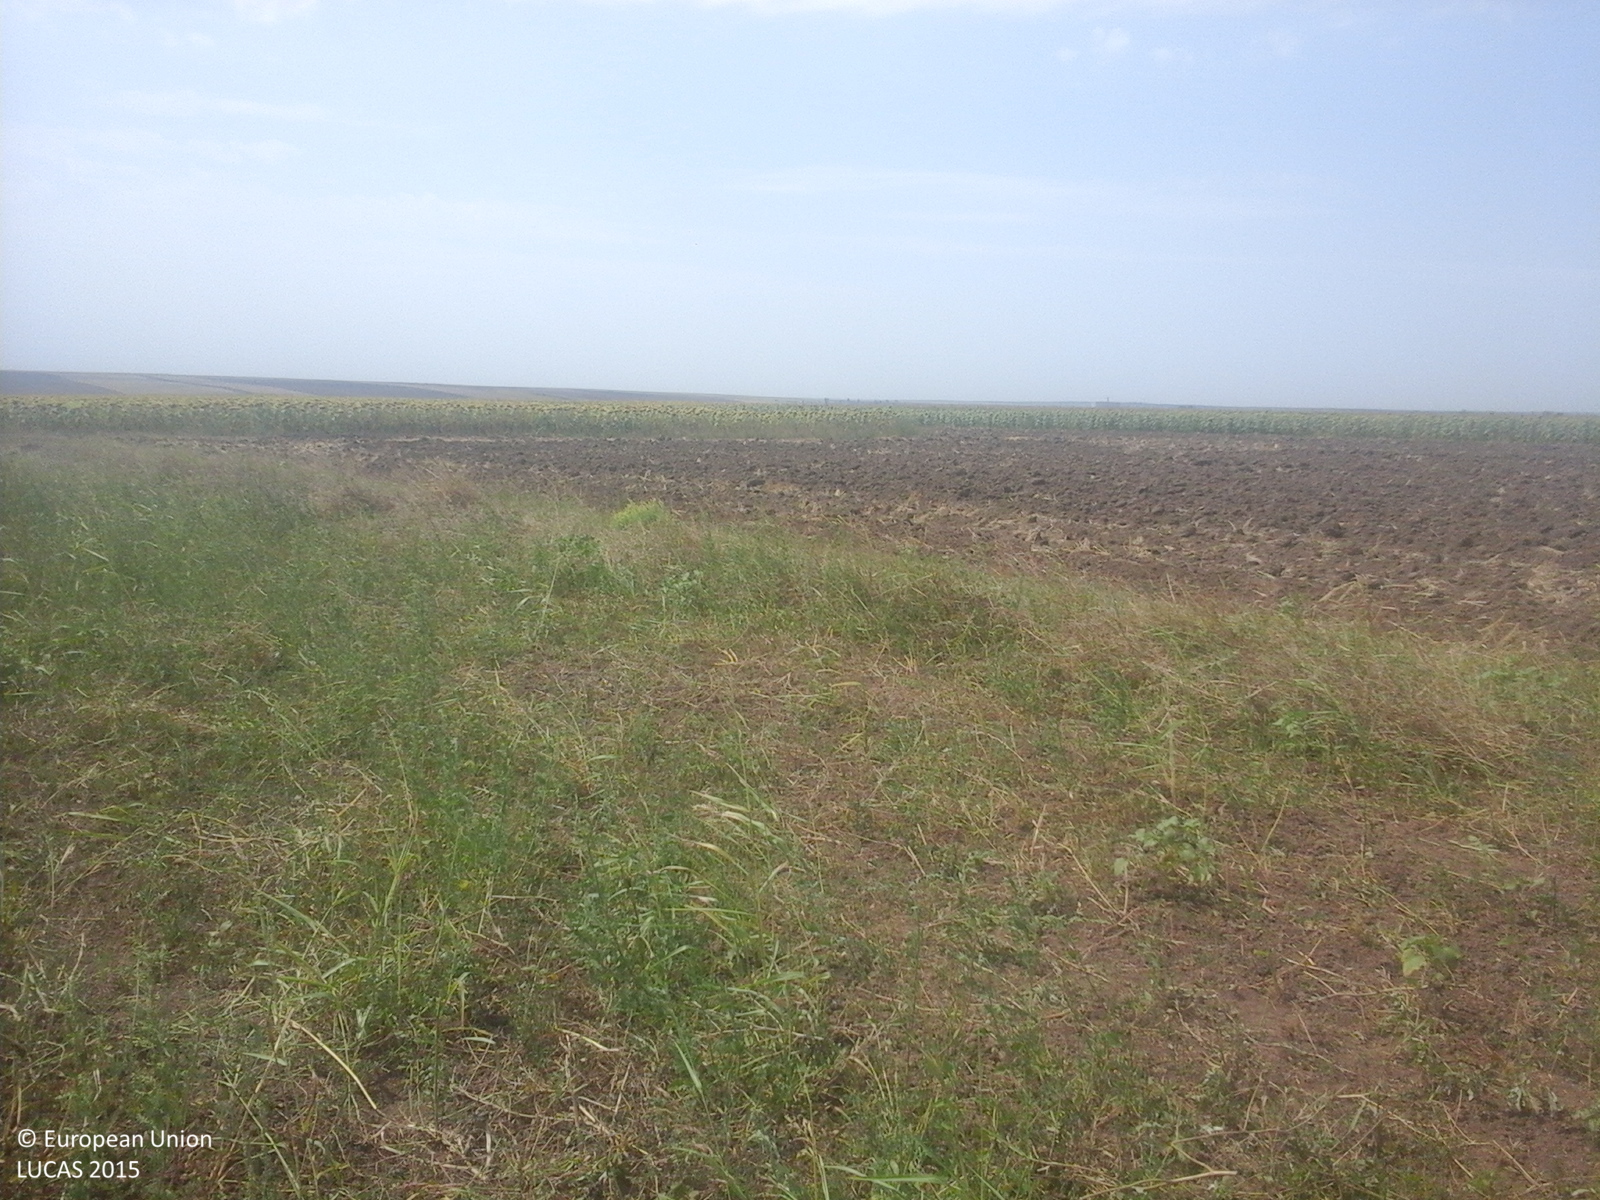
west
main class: Grassland
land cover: Spontaneously vegetated surfaces
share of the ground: < 10 %
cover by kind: herbaceous plants 100 %
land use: Fallow land
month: August
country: RO
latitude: 43.9404
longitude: 28.3127
